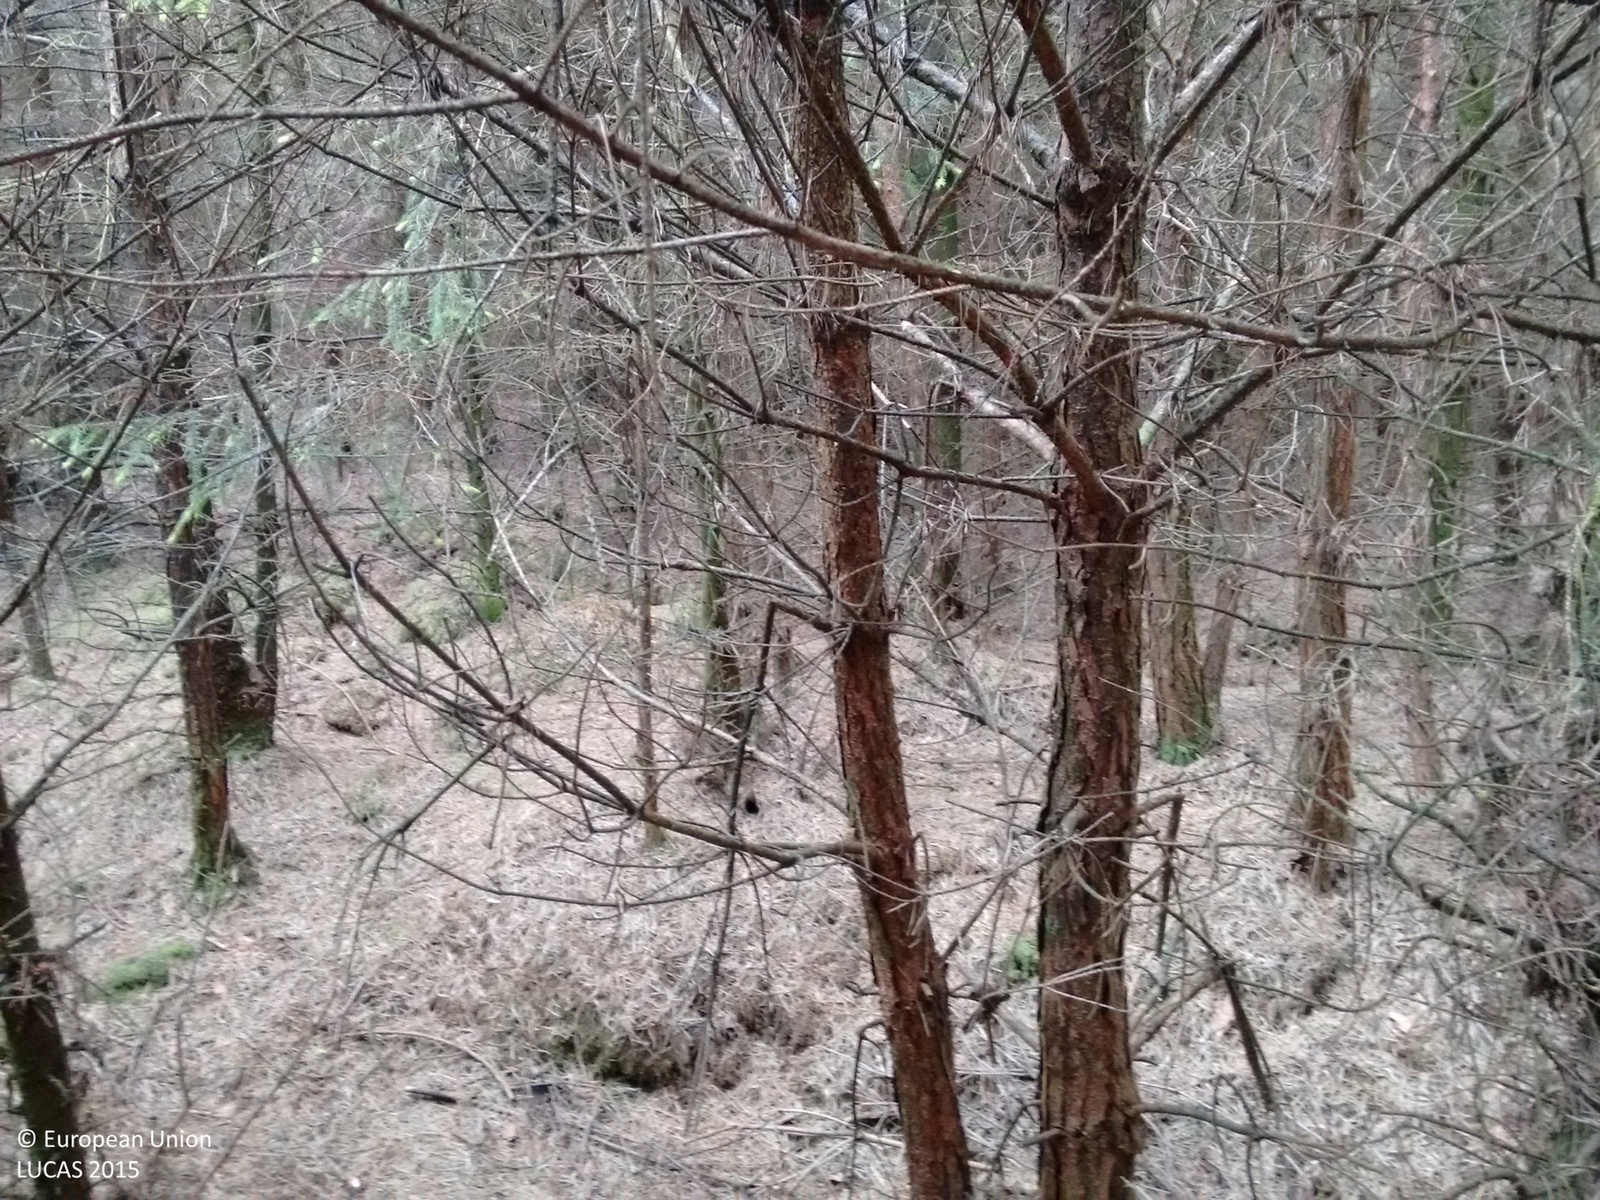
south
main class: Woodland
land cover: Pine dominated coniferous woodland
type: exotic forest
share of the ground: > 75 %
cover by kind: coniferous forest trees 80 %, broadleaved forest trees 20 %
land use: Forestry
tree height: > 5 m
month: June
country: GB
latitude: 54.3107
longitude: -0.8455
